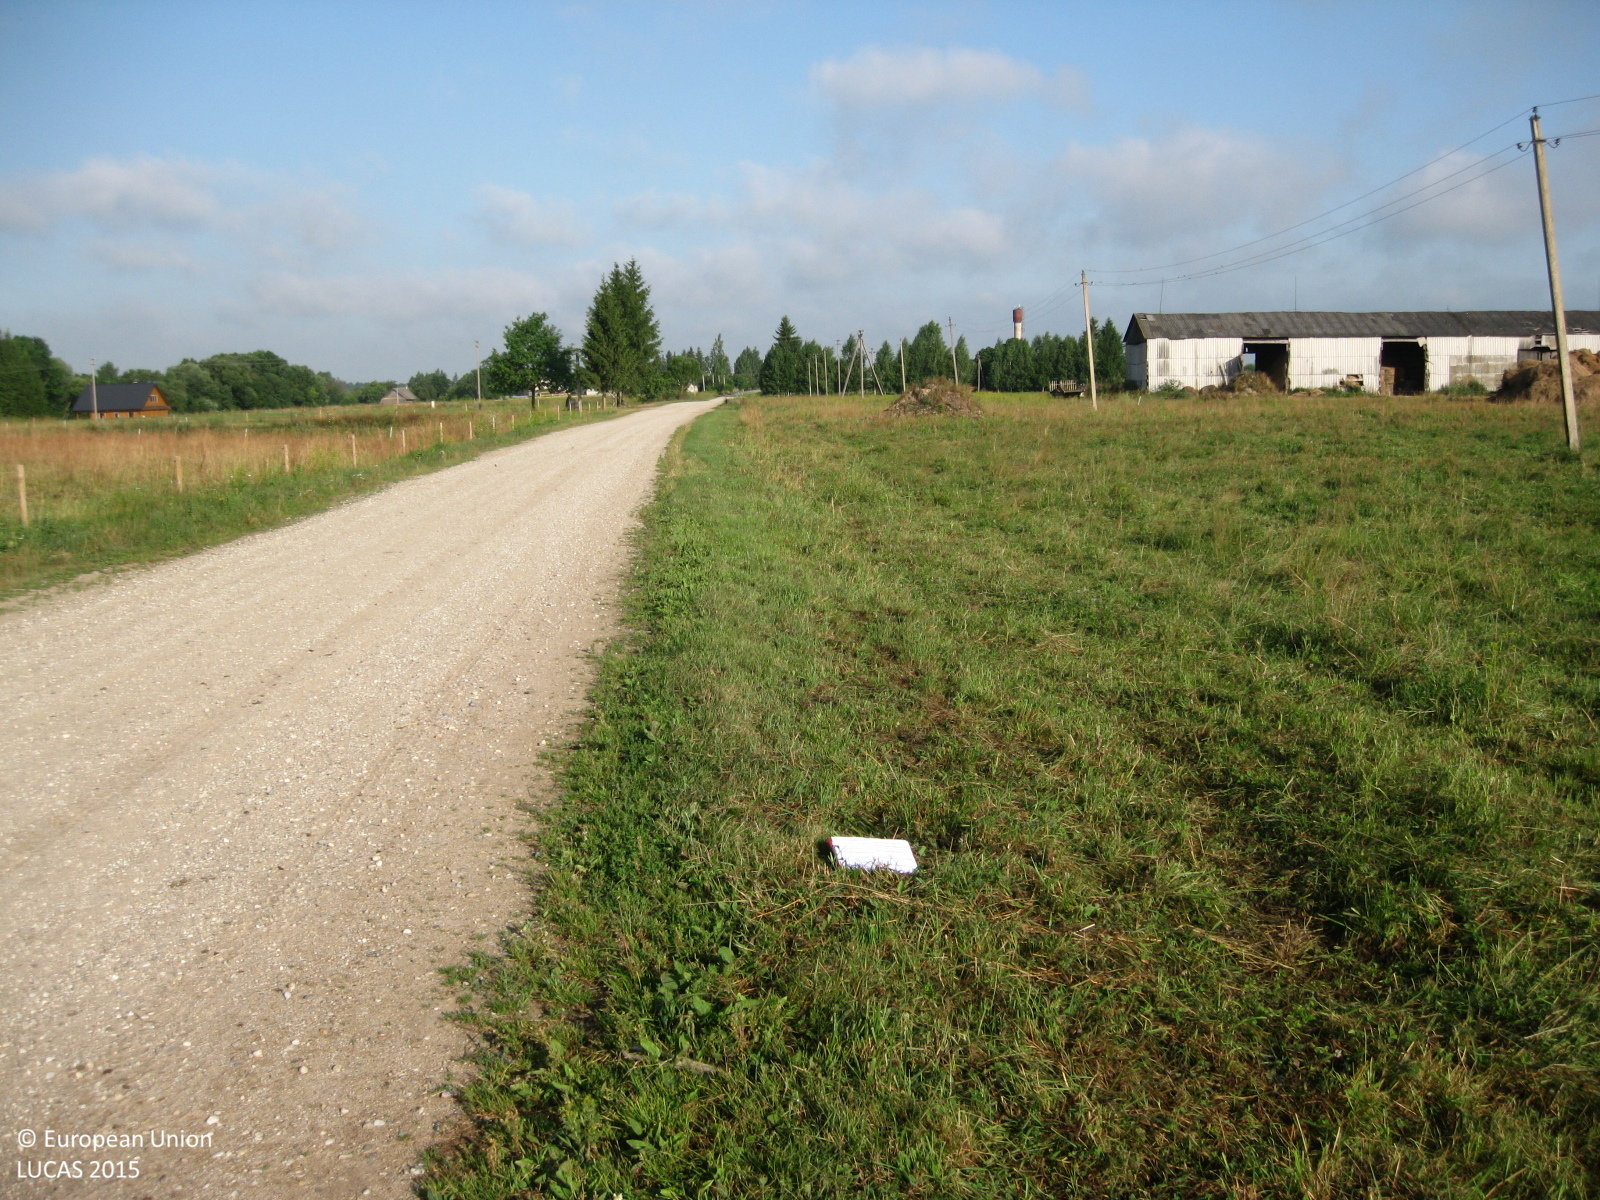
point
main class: Grassland
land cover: Grassland without tree/shrub cover
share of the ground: > 75 %
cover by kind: herbaceous plants 100 %
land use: Agriculture (excluding fallow land and kitchen gardens)
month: July
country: LT
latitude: 55.3118
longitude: 24.5819
